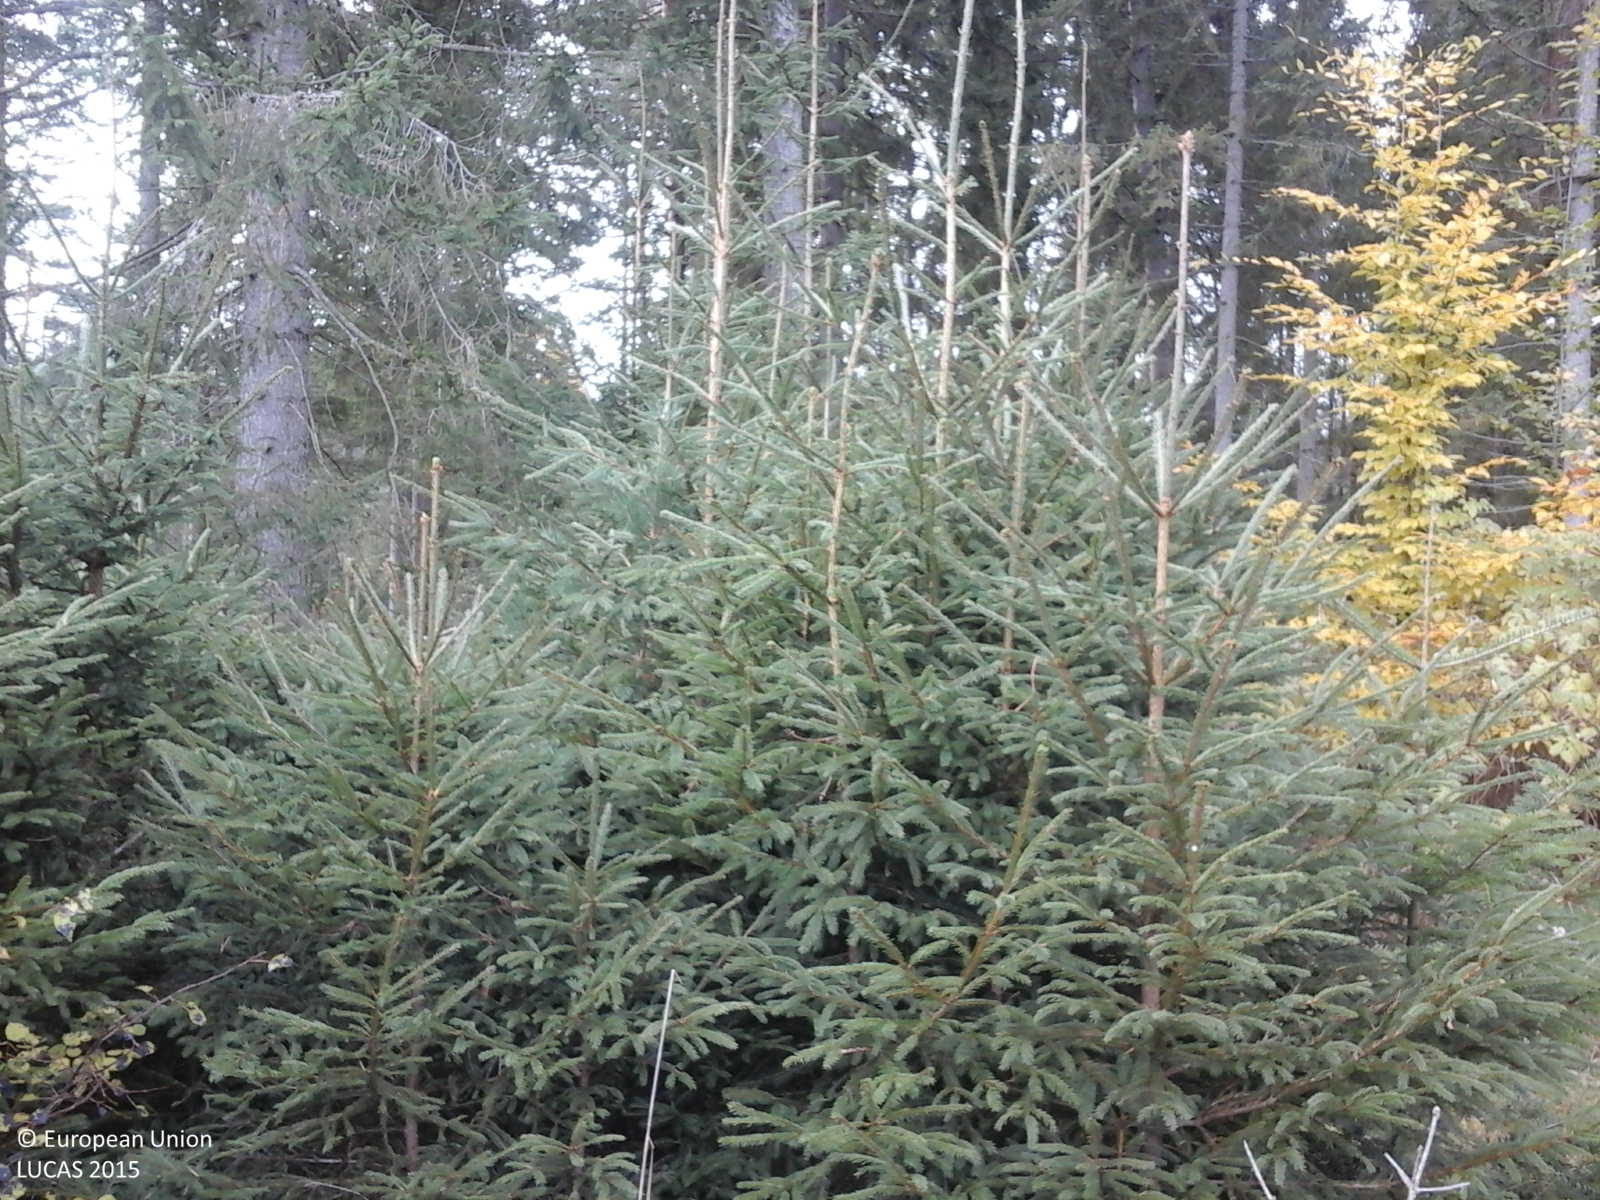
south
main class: Grassland
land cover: Grassland with sparse tree/shrub cover
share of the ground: > 75 %
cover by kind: herbaceous plants 85 %, shrubs 10 %, broadleaved forest trees 5 %
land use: Fallow land
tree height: < 5 m
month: October
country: RO
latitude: 46.4796
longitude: 25.3581
